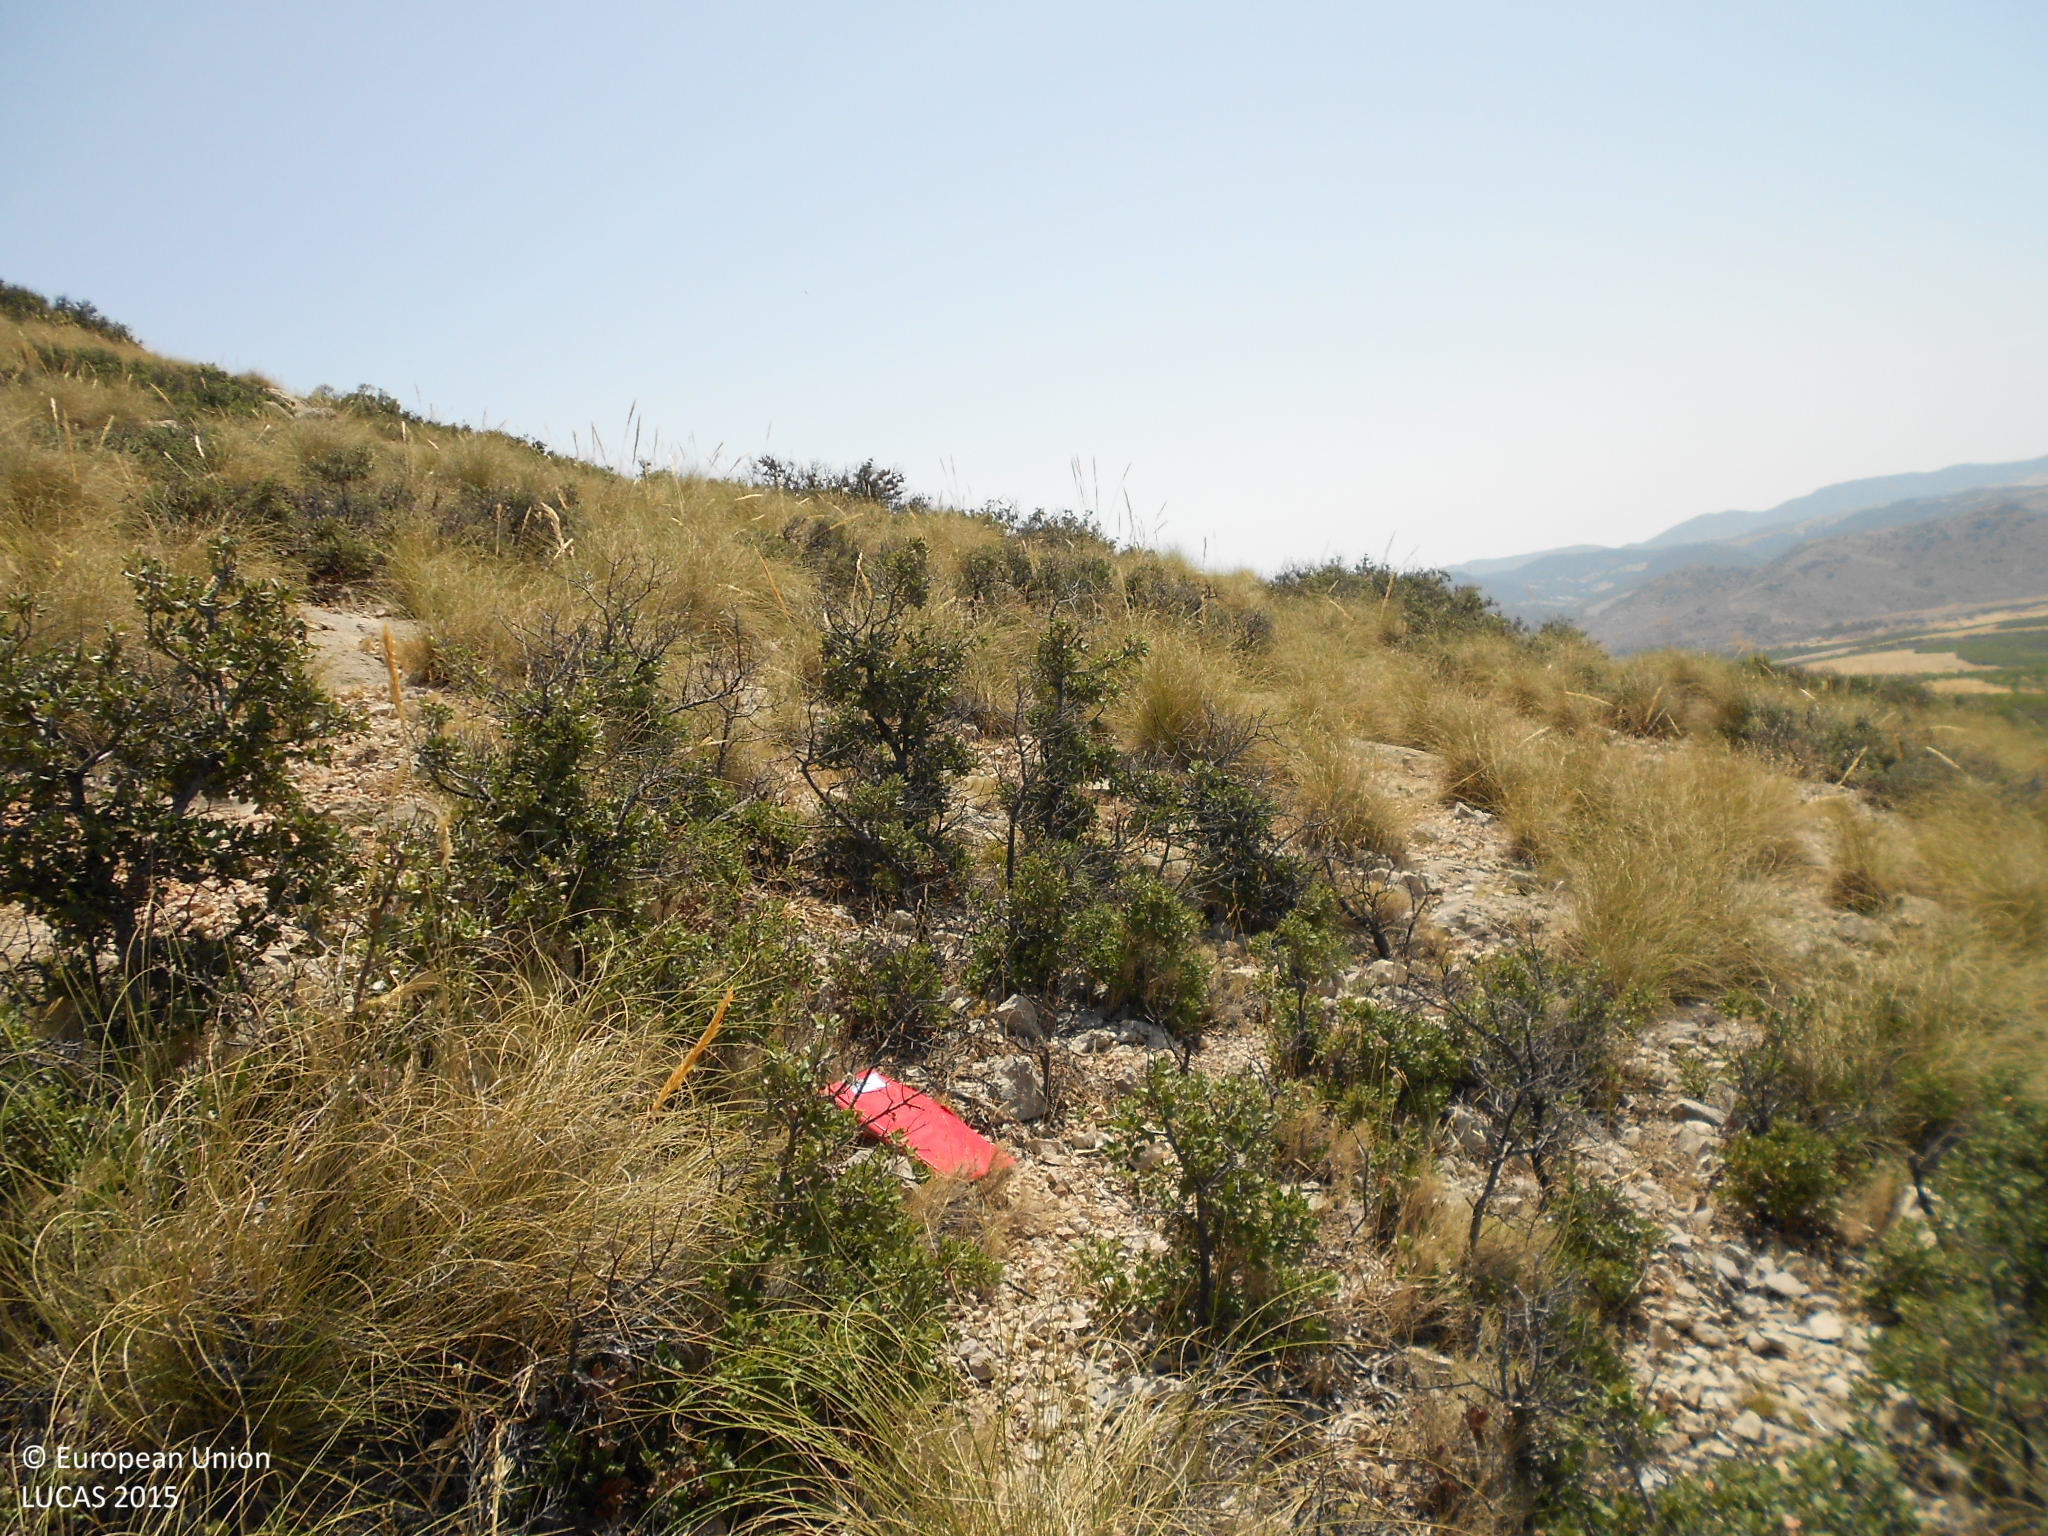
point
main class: Shrubland
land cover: Shrubland without tree cover
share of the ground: 50 - 75 %
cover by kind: shrubs 60 %, herbaceous plants 20 %, consolidated bare surface 20 %
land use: Semi-natural and natural areas not in use
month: July
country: ES
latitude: 37.6322
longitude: -2.2347
